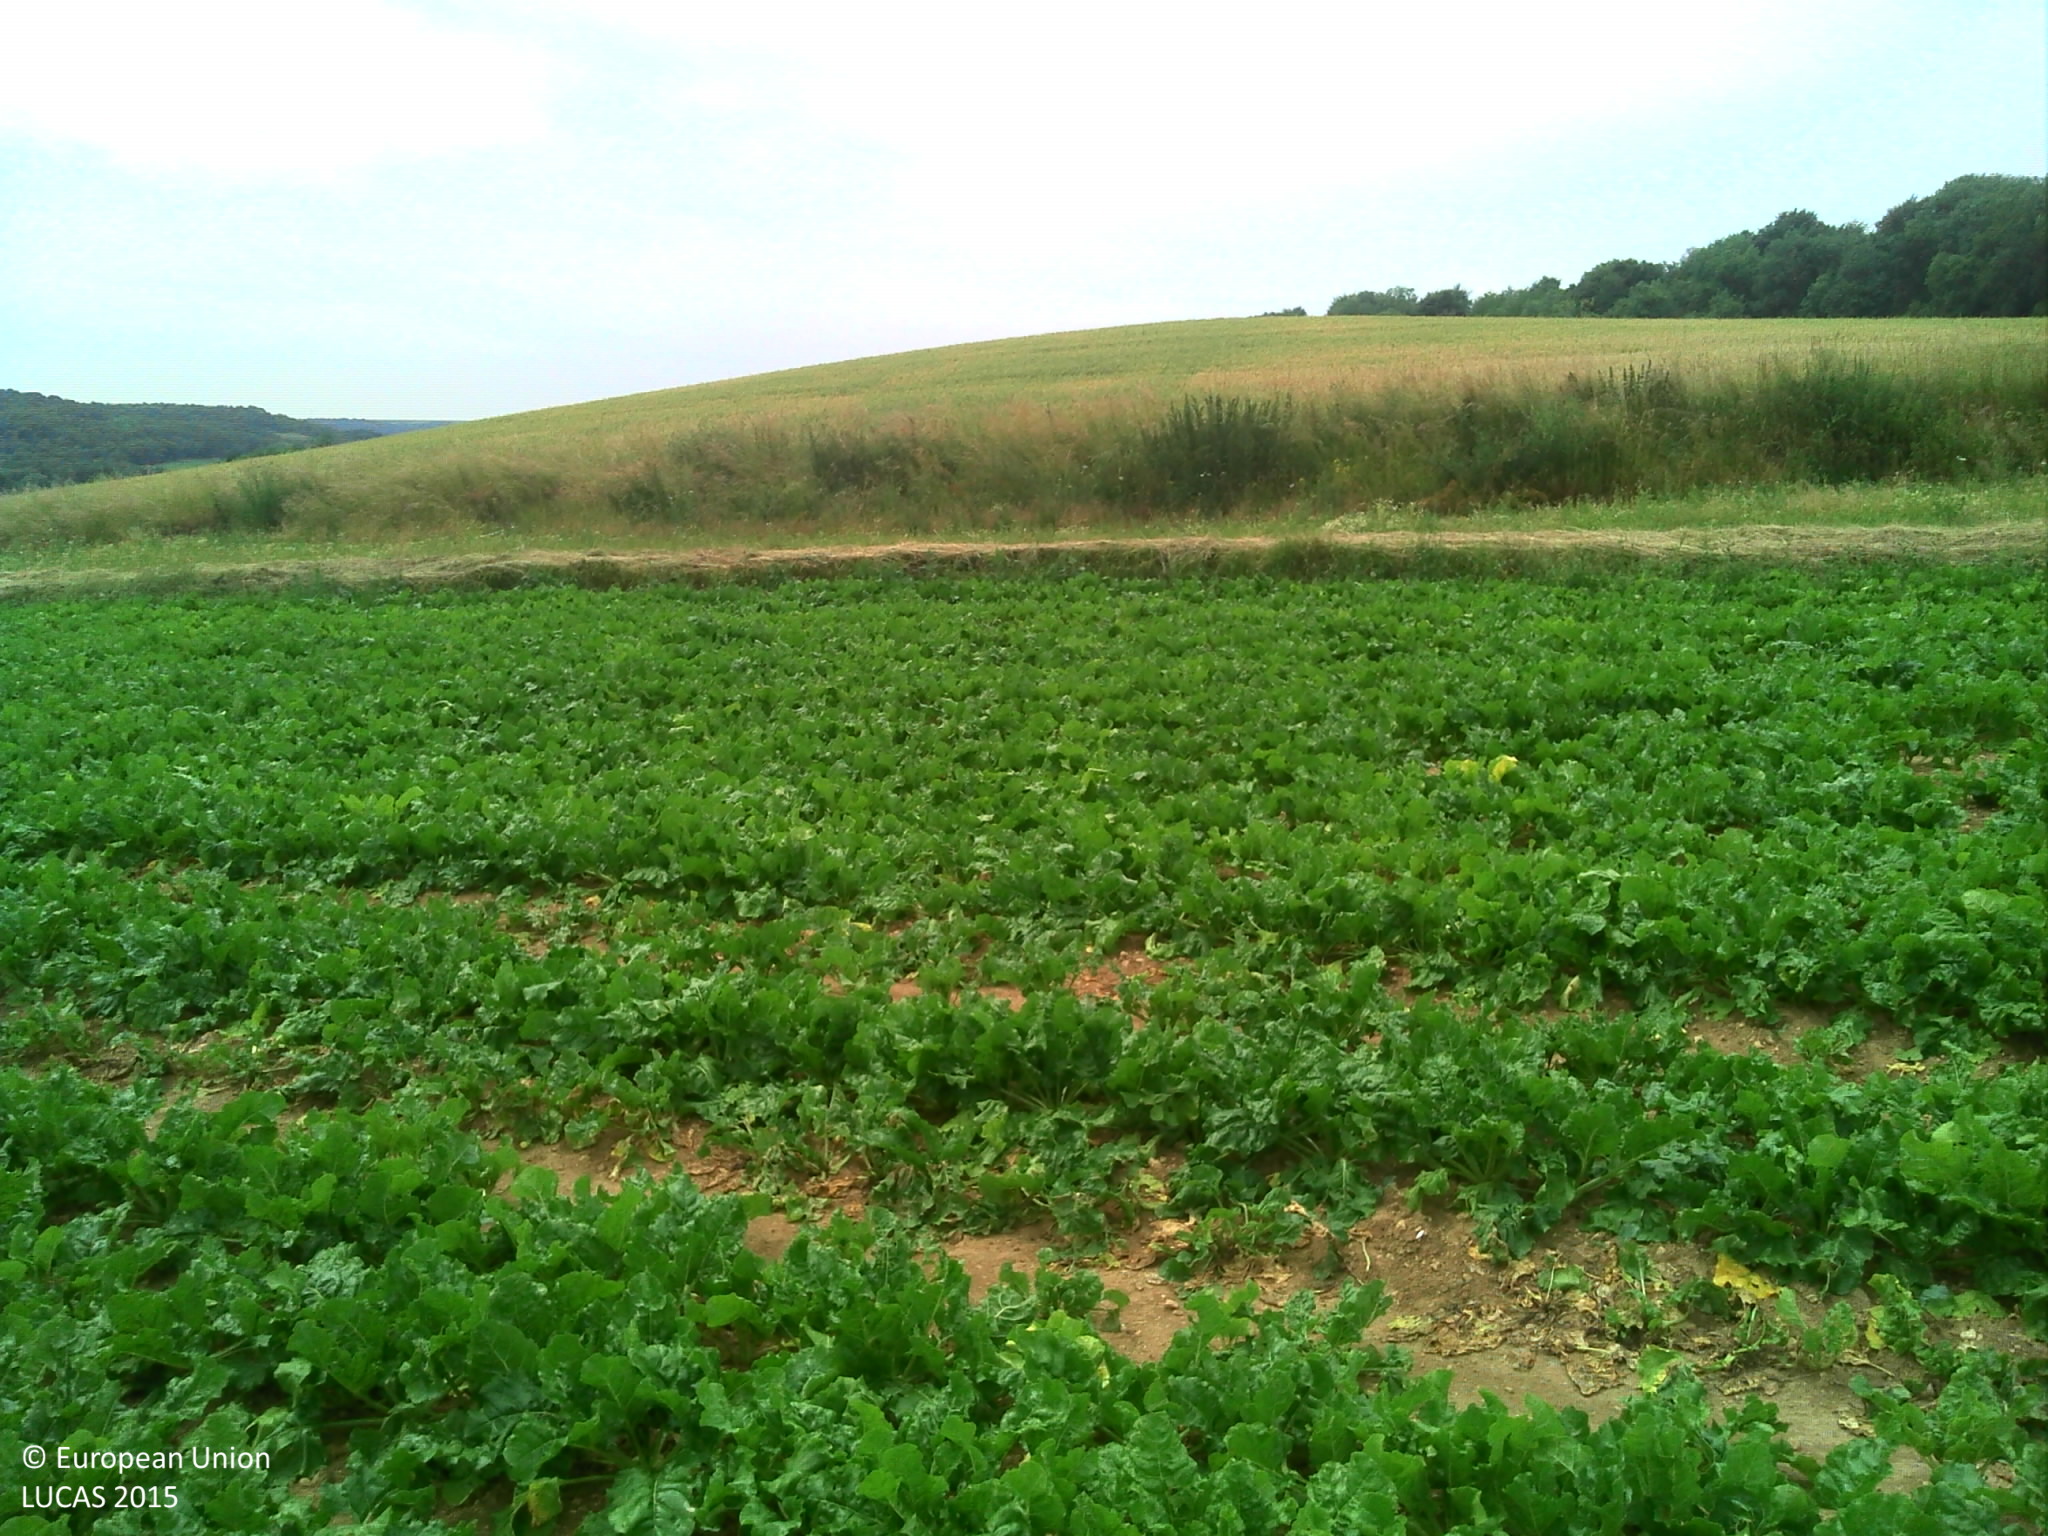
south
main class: Cropland
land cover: Sugar beet
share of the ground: > 75 %
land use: Agriculture (excluding fallow land and kitchen gardens)
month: June
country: FR
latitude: 49.4292
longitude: 3.6371
